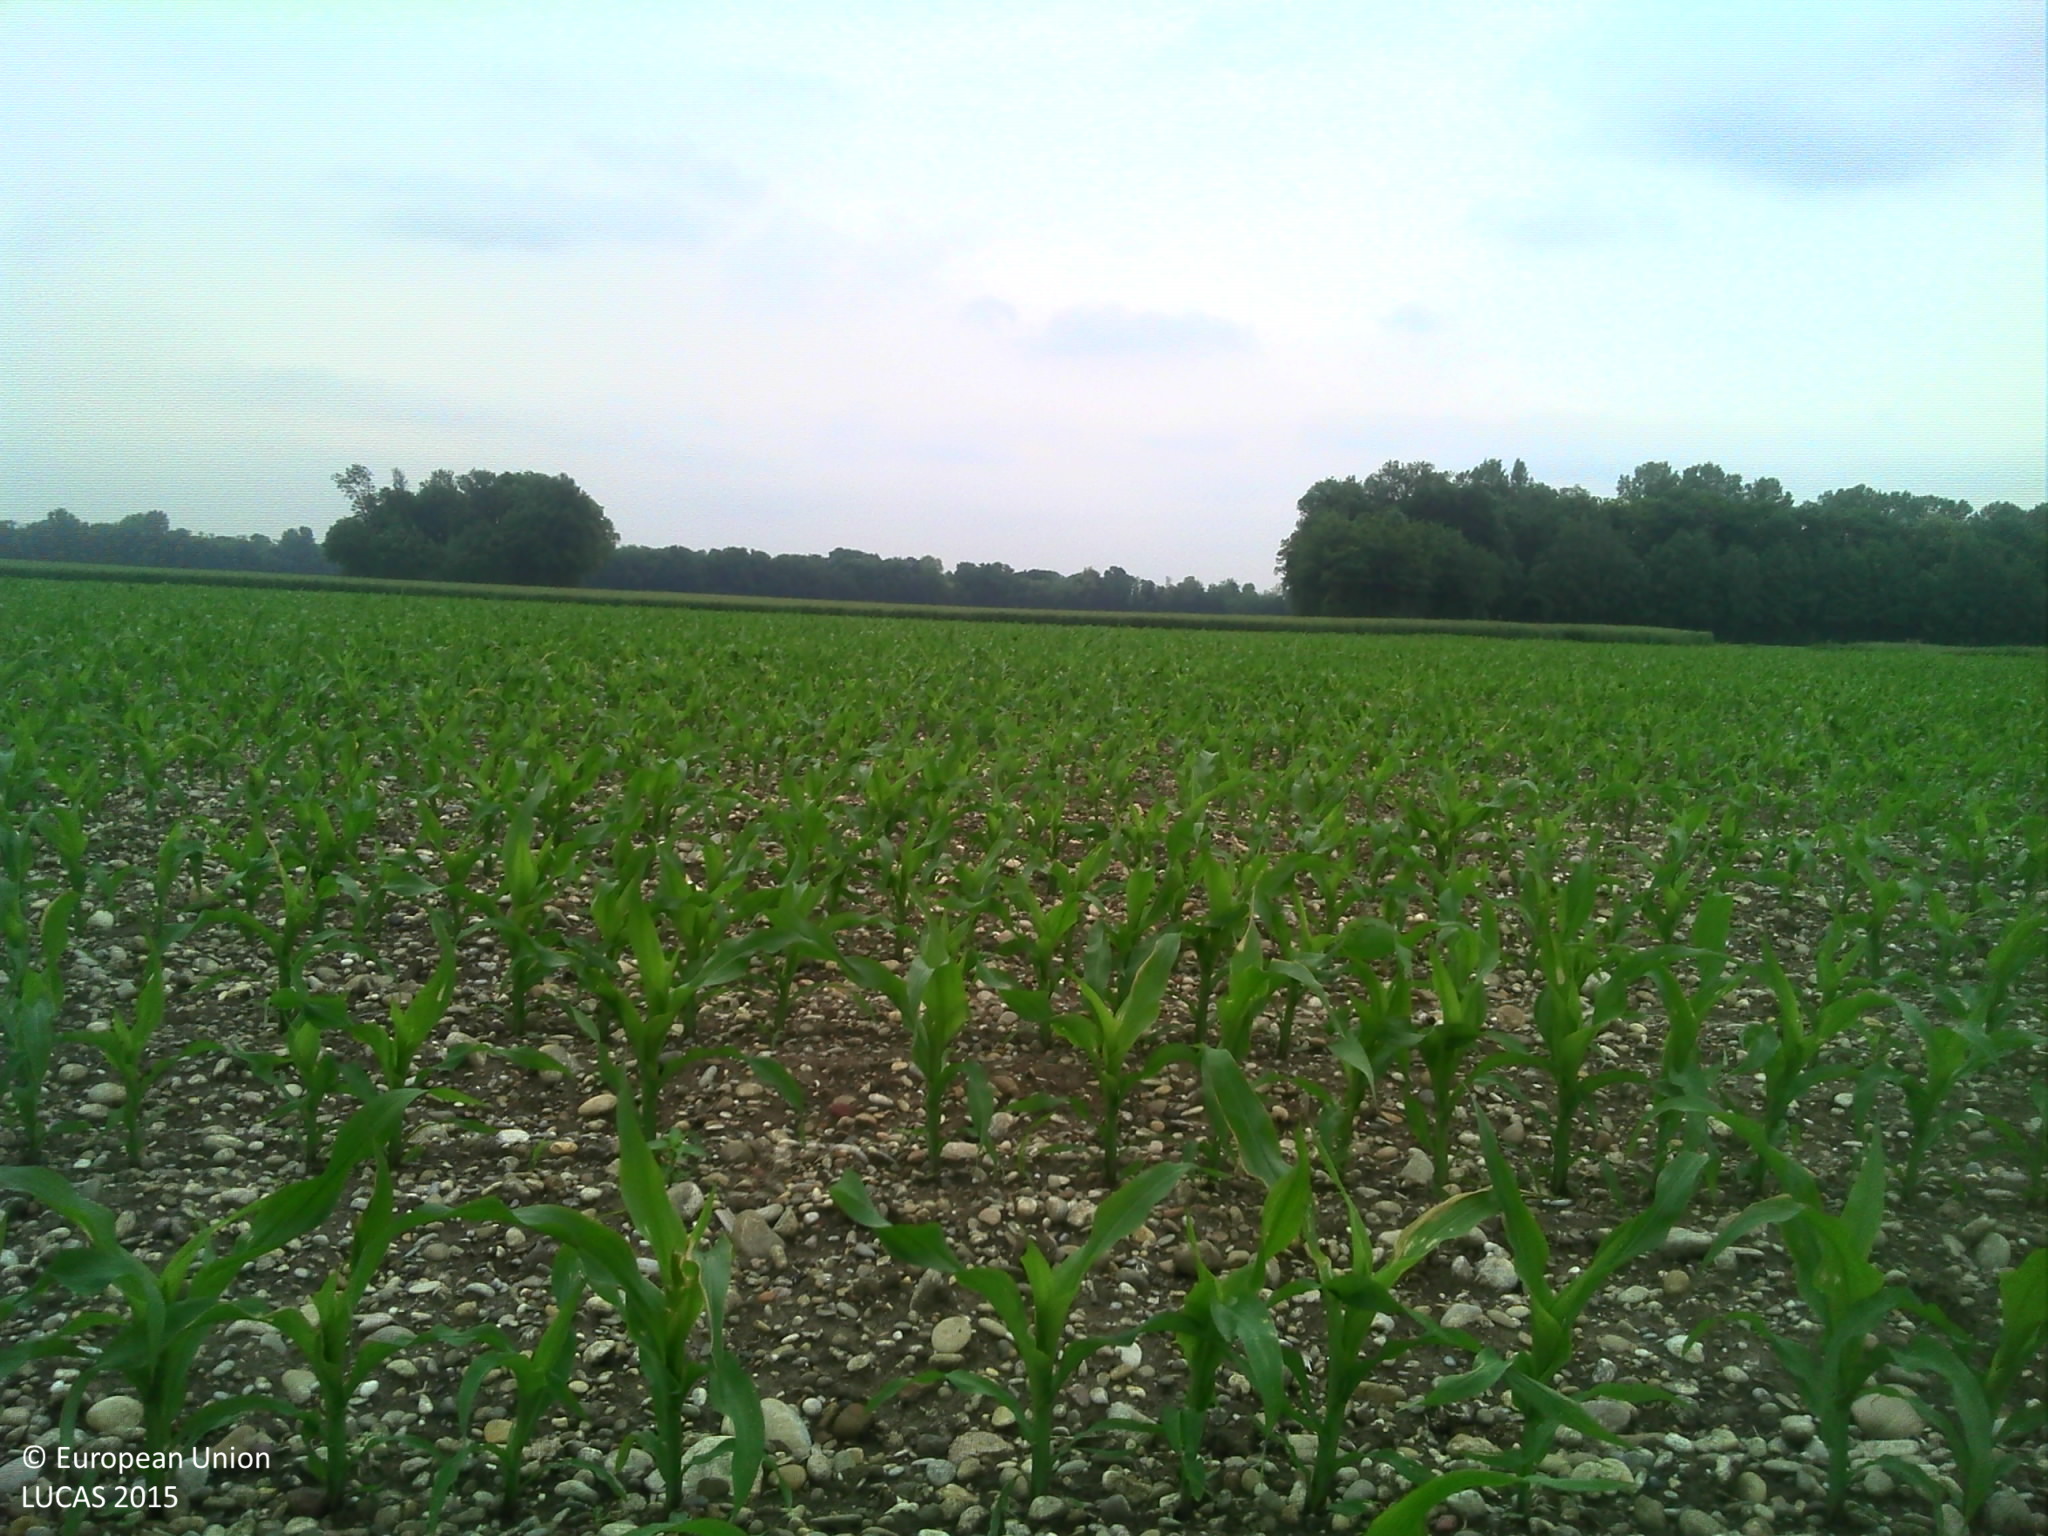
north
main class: Cropland
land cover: Maize
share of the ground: < 10 %
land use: Agriculture (excluding fallow land and kitchen gardens)
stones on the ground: > 50 %
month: May
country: FR
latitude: 48.2878
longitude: 7.6155
